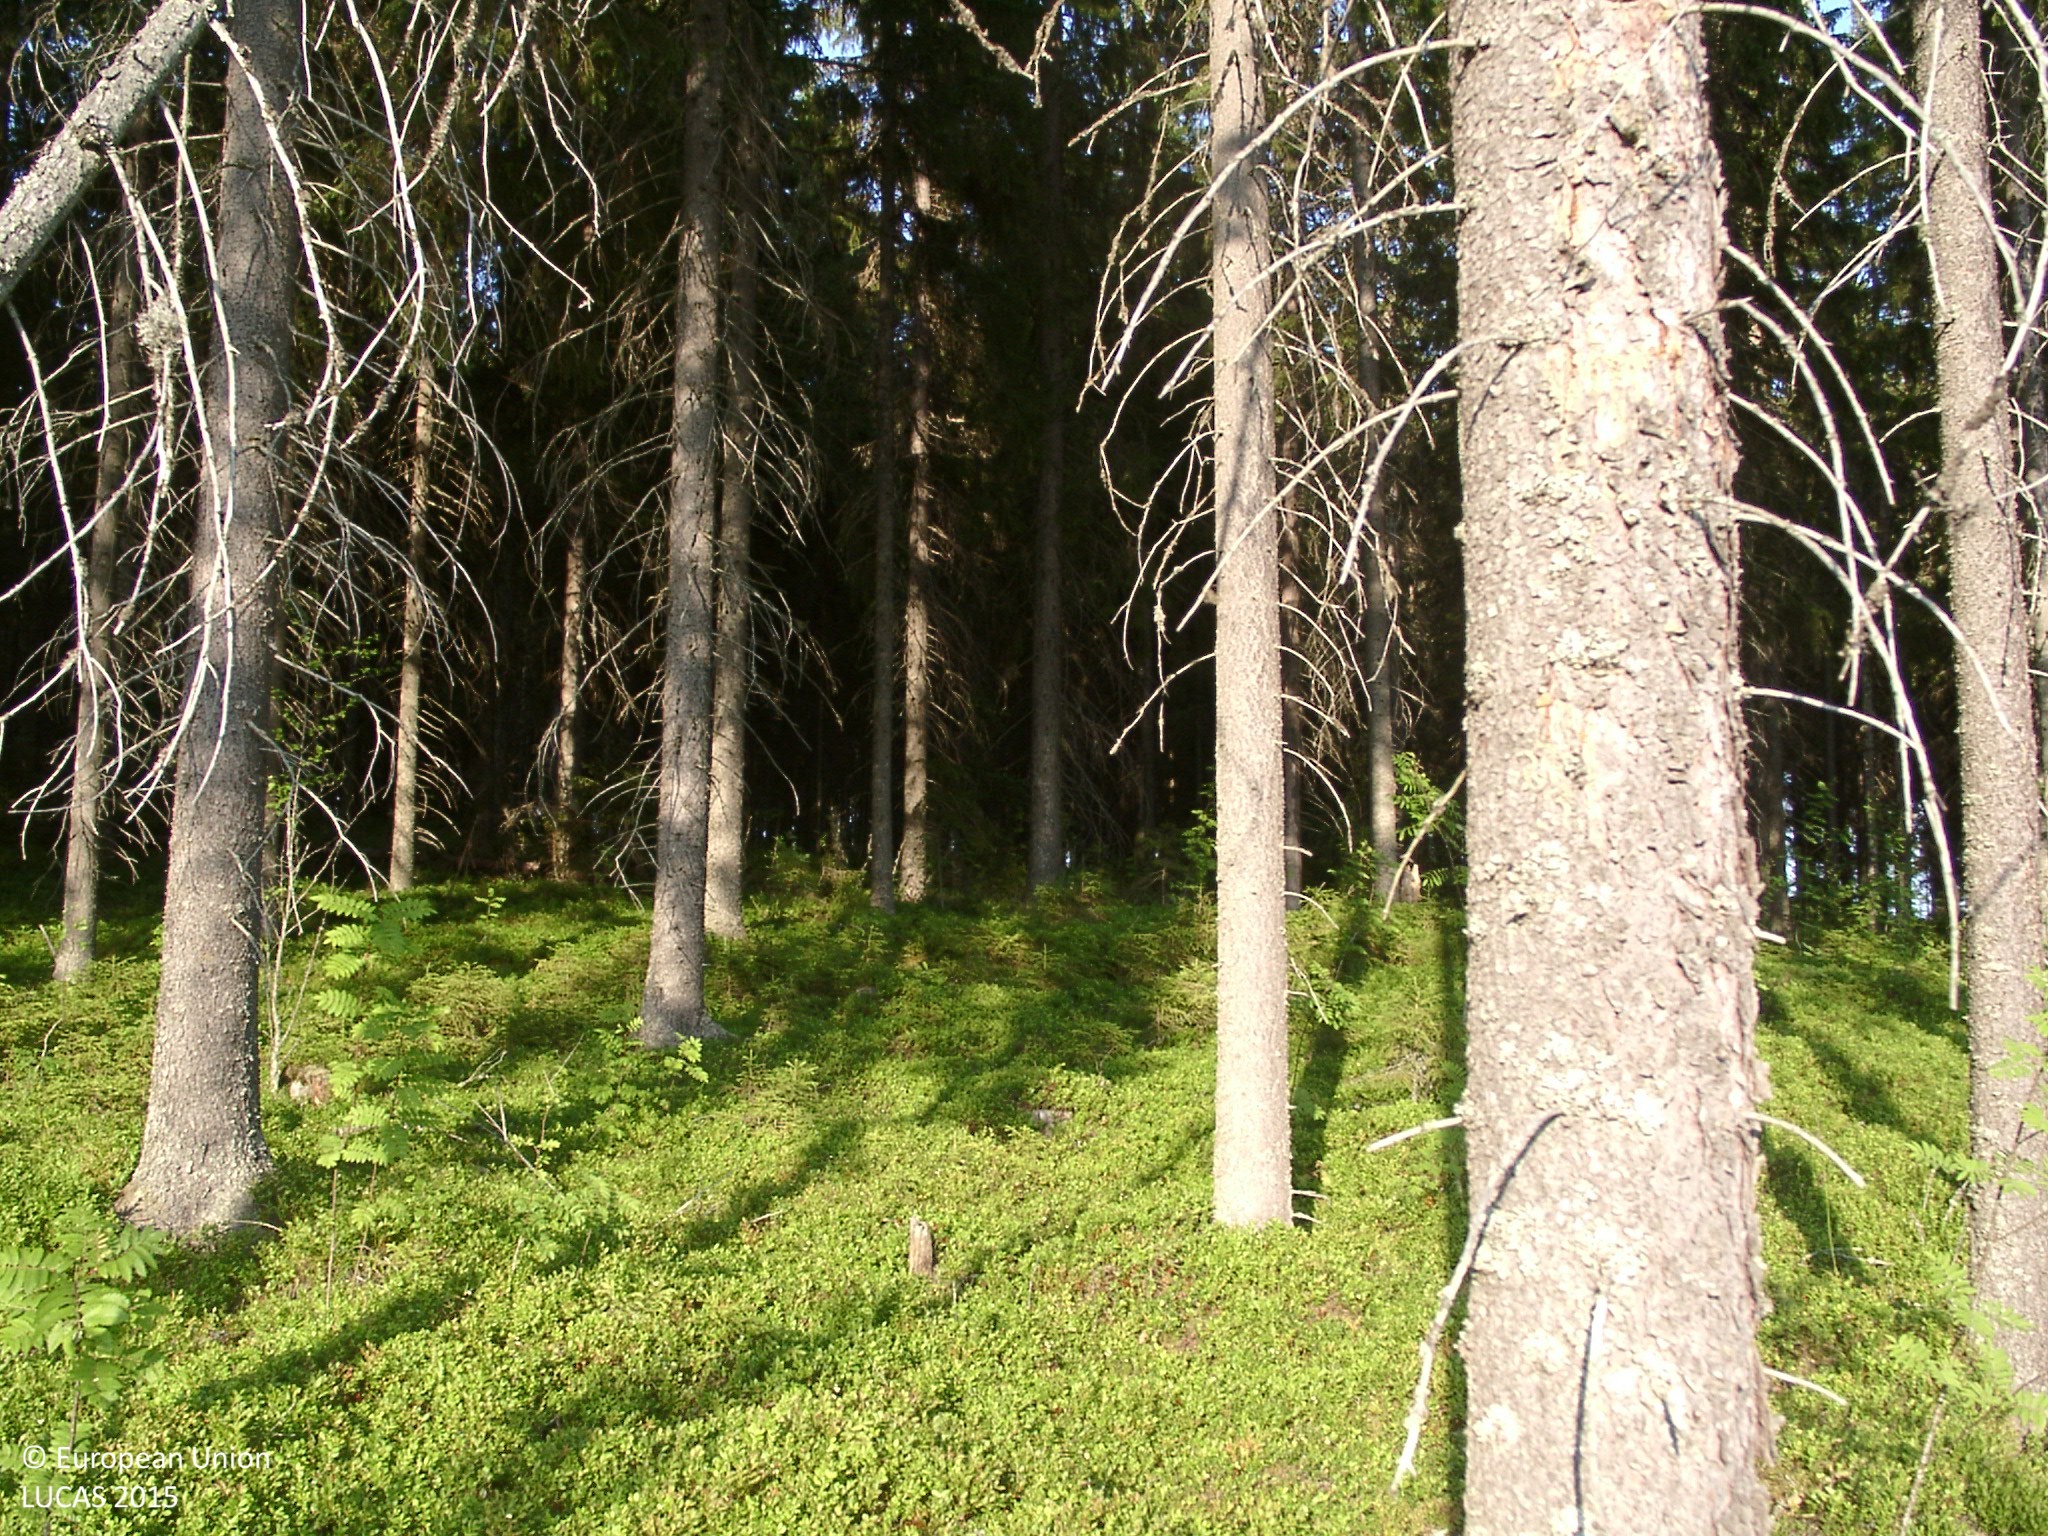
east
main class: Woodland
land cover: Spruce dominated coniferous woodland
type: boreal forest
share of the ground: > 75 %
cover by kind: coniferous forest trees 70 %, shrubs 20 %, broadleaved forest trees 5 %, lichens and mosses 5 %
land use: Forestry
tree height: > 5 m
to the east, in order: Spruce dominated coniferous woodland; Shruby margins; Spruce dominated coniferous woodland; Shruby margins; Spruce dominated coniferous woodland; Other mixed woodland
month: July
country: FI
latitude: 61.8048
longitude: 24.7674
